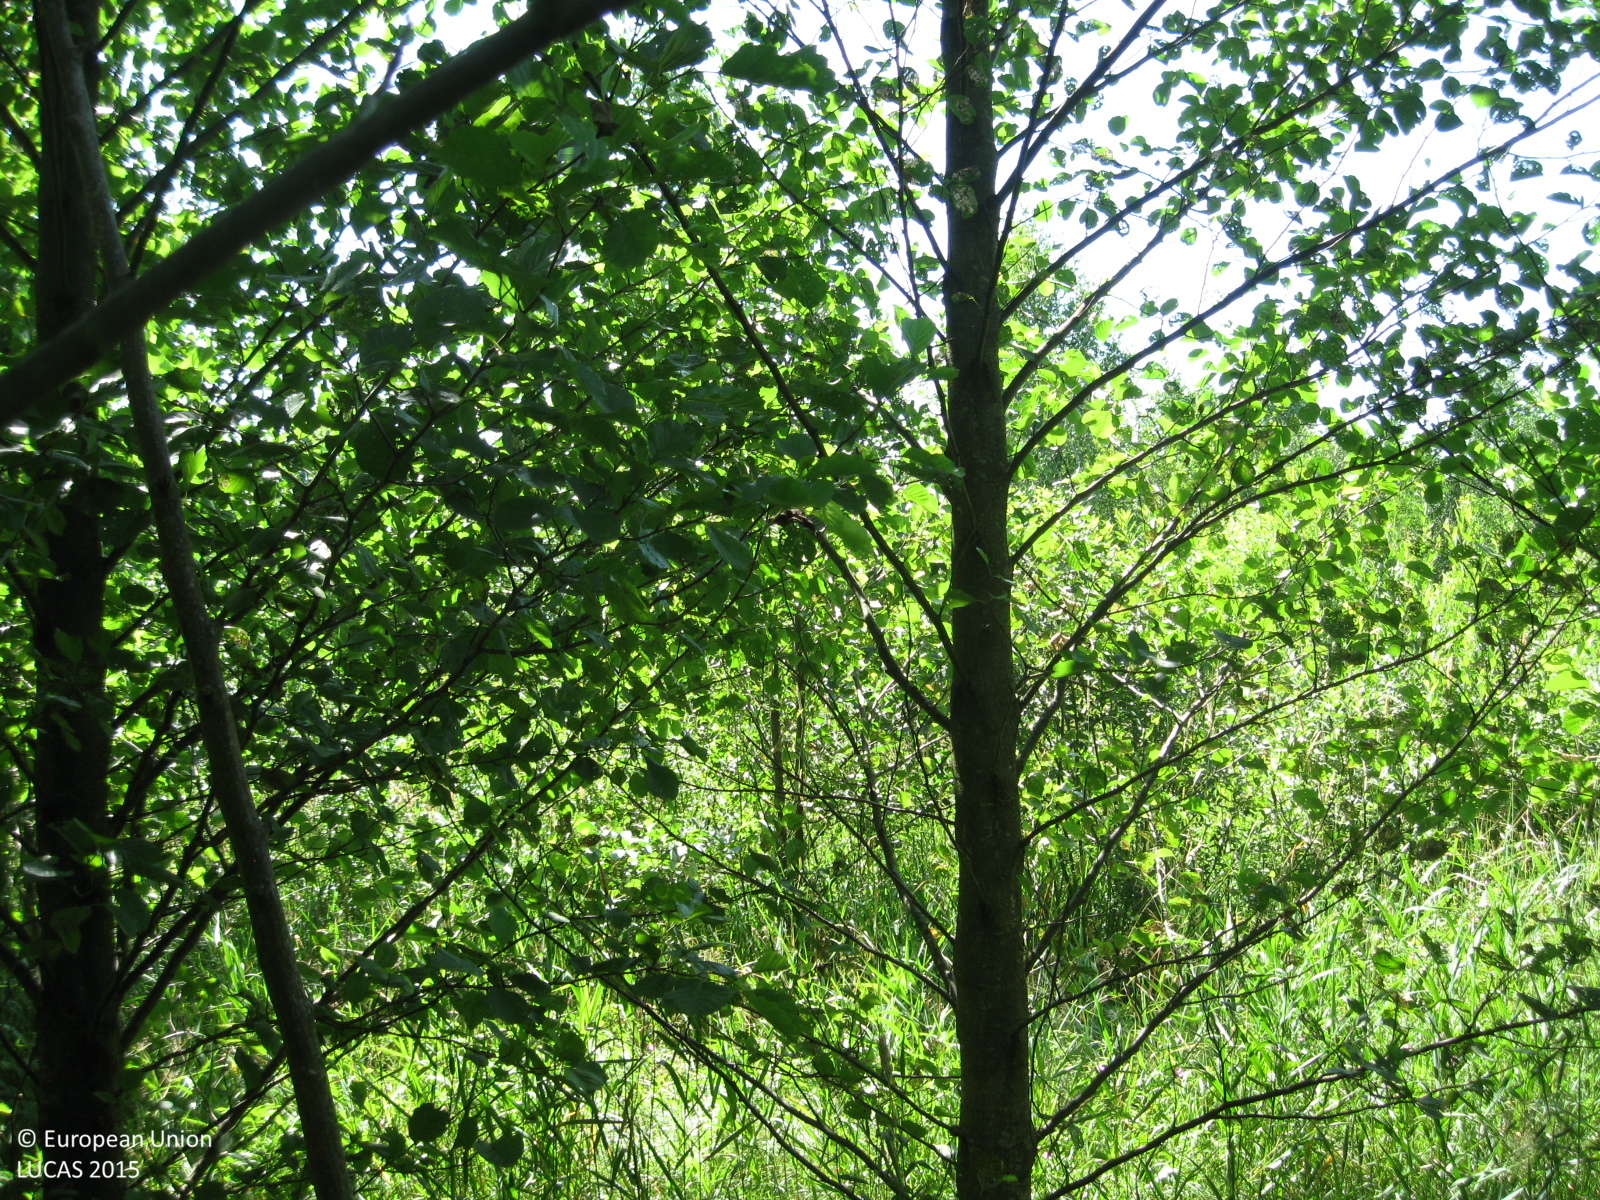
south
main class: Woodland
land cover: Broadleaved woodland
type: non-riverine alder, birch or aspen forest
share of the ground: > 75 %
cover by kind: broadleaved forest trees 75 %, herbaceous plants 25 %
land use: Forestry
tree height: > 5 m
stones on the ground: < 10 %
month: July
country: LT
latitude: 55.1394
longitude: 24.6470
